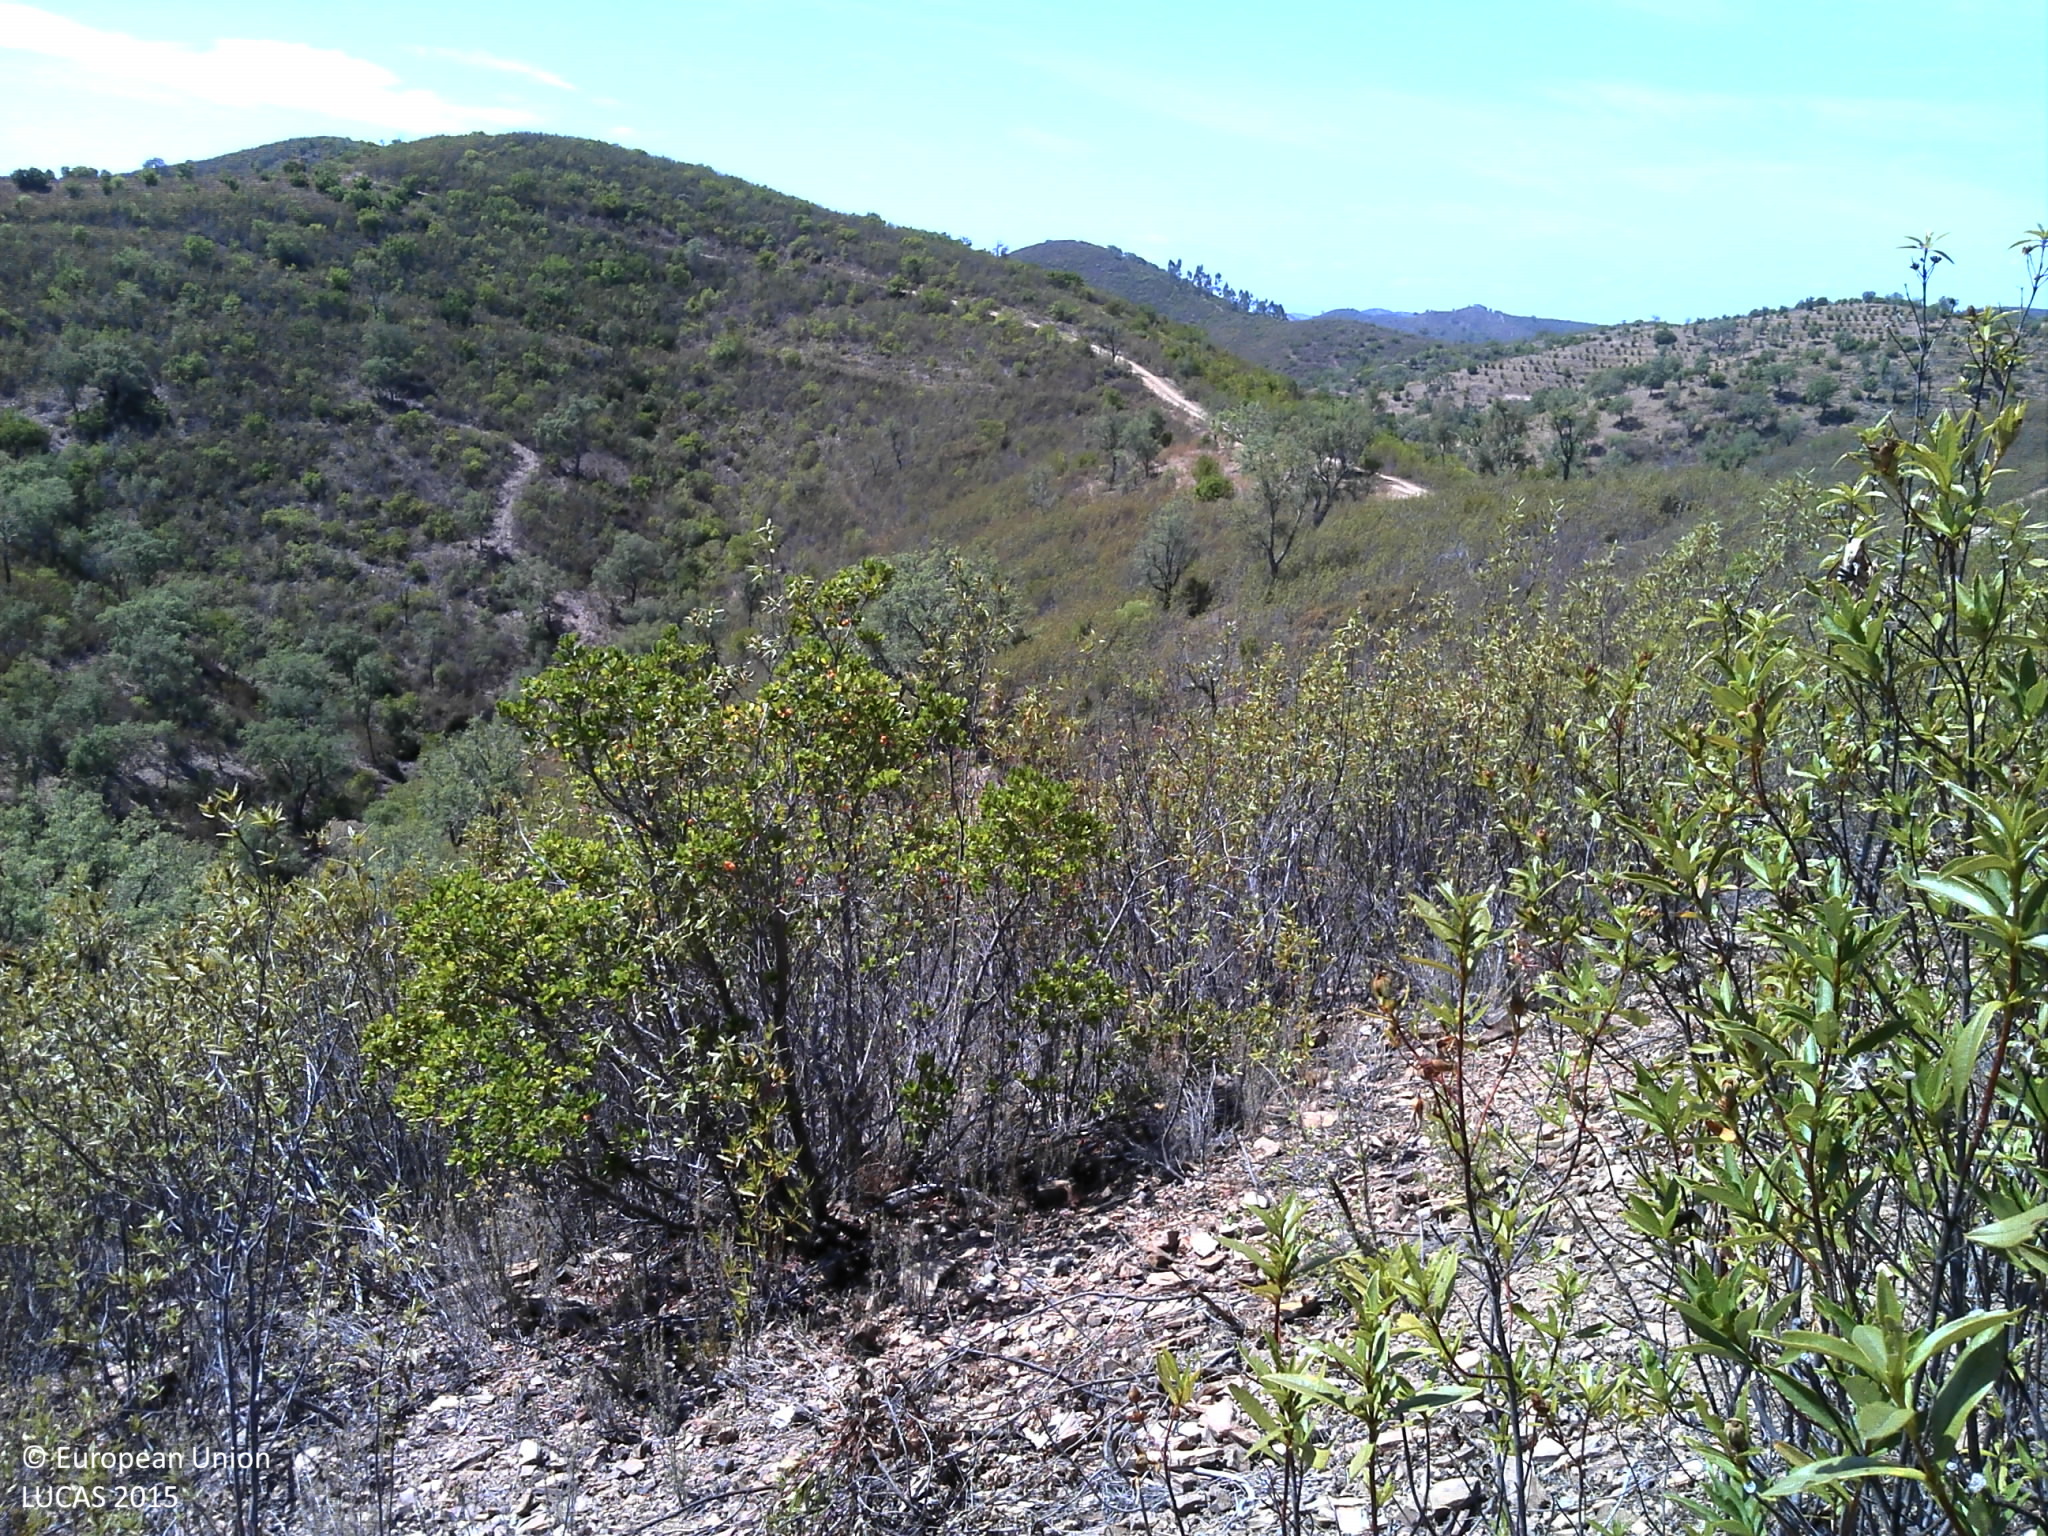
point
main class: Shrubland
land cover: Shrubland with sparse tree cover
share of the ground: 50 - 75 %
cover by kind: shrubs 60 %, unconsolidated bare surface 30 %, broadleaved forest trees 5 %, herbaceous plants 5 %
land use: Forestry
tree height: < 5 m
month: September
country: PT
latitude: 37.3883
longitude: -8.1727
